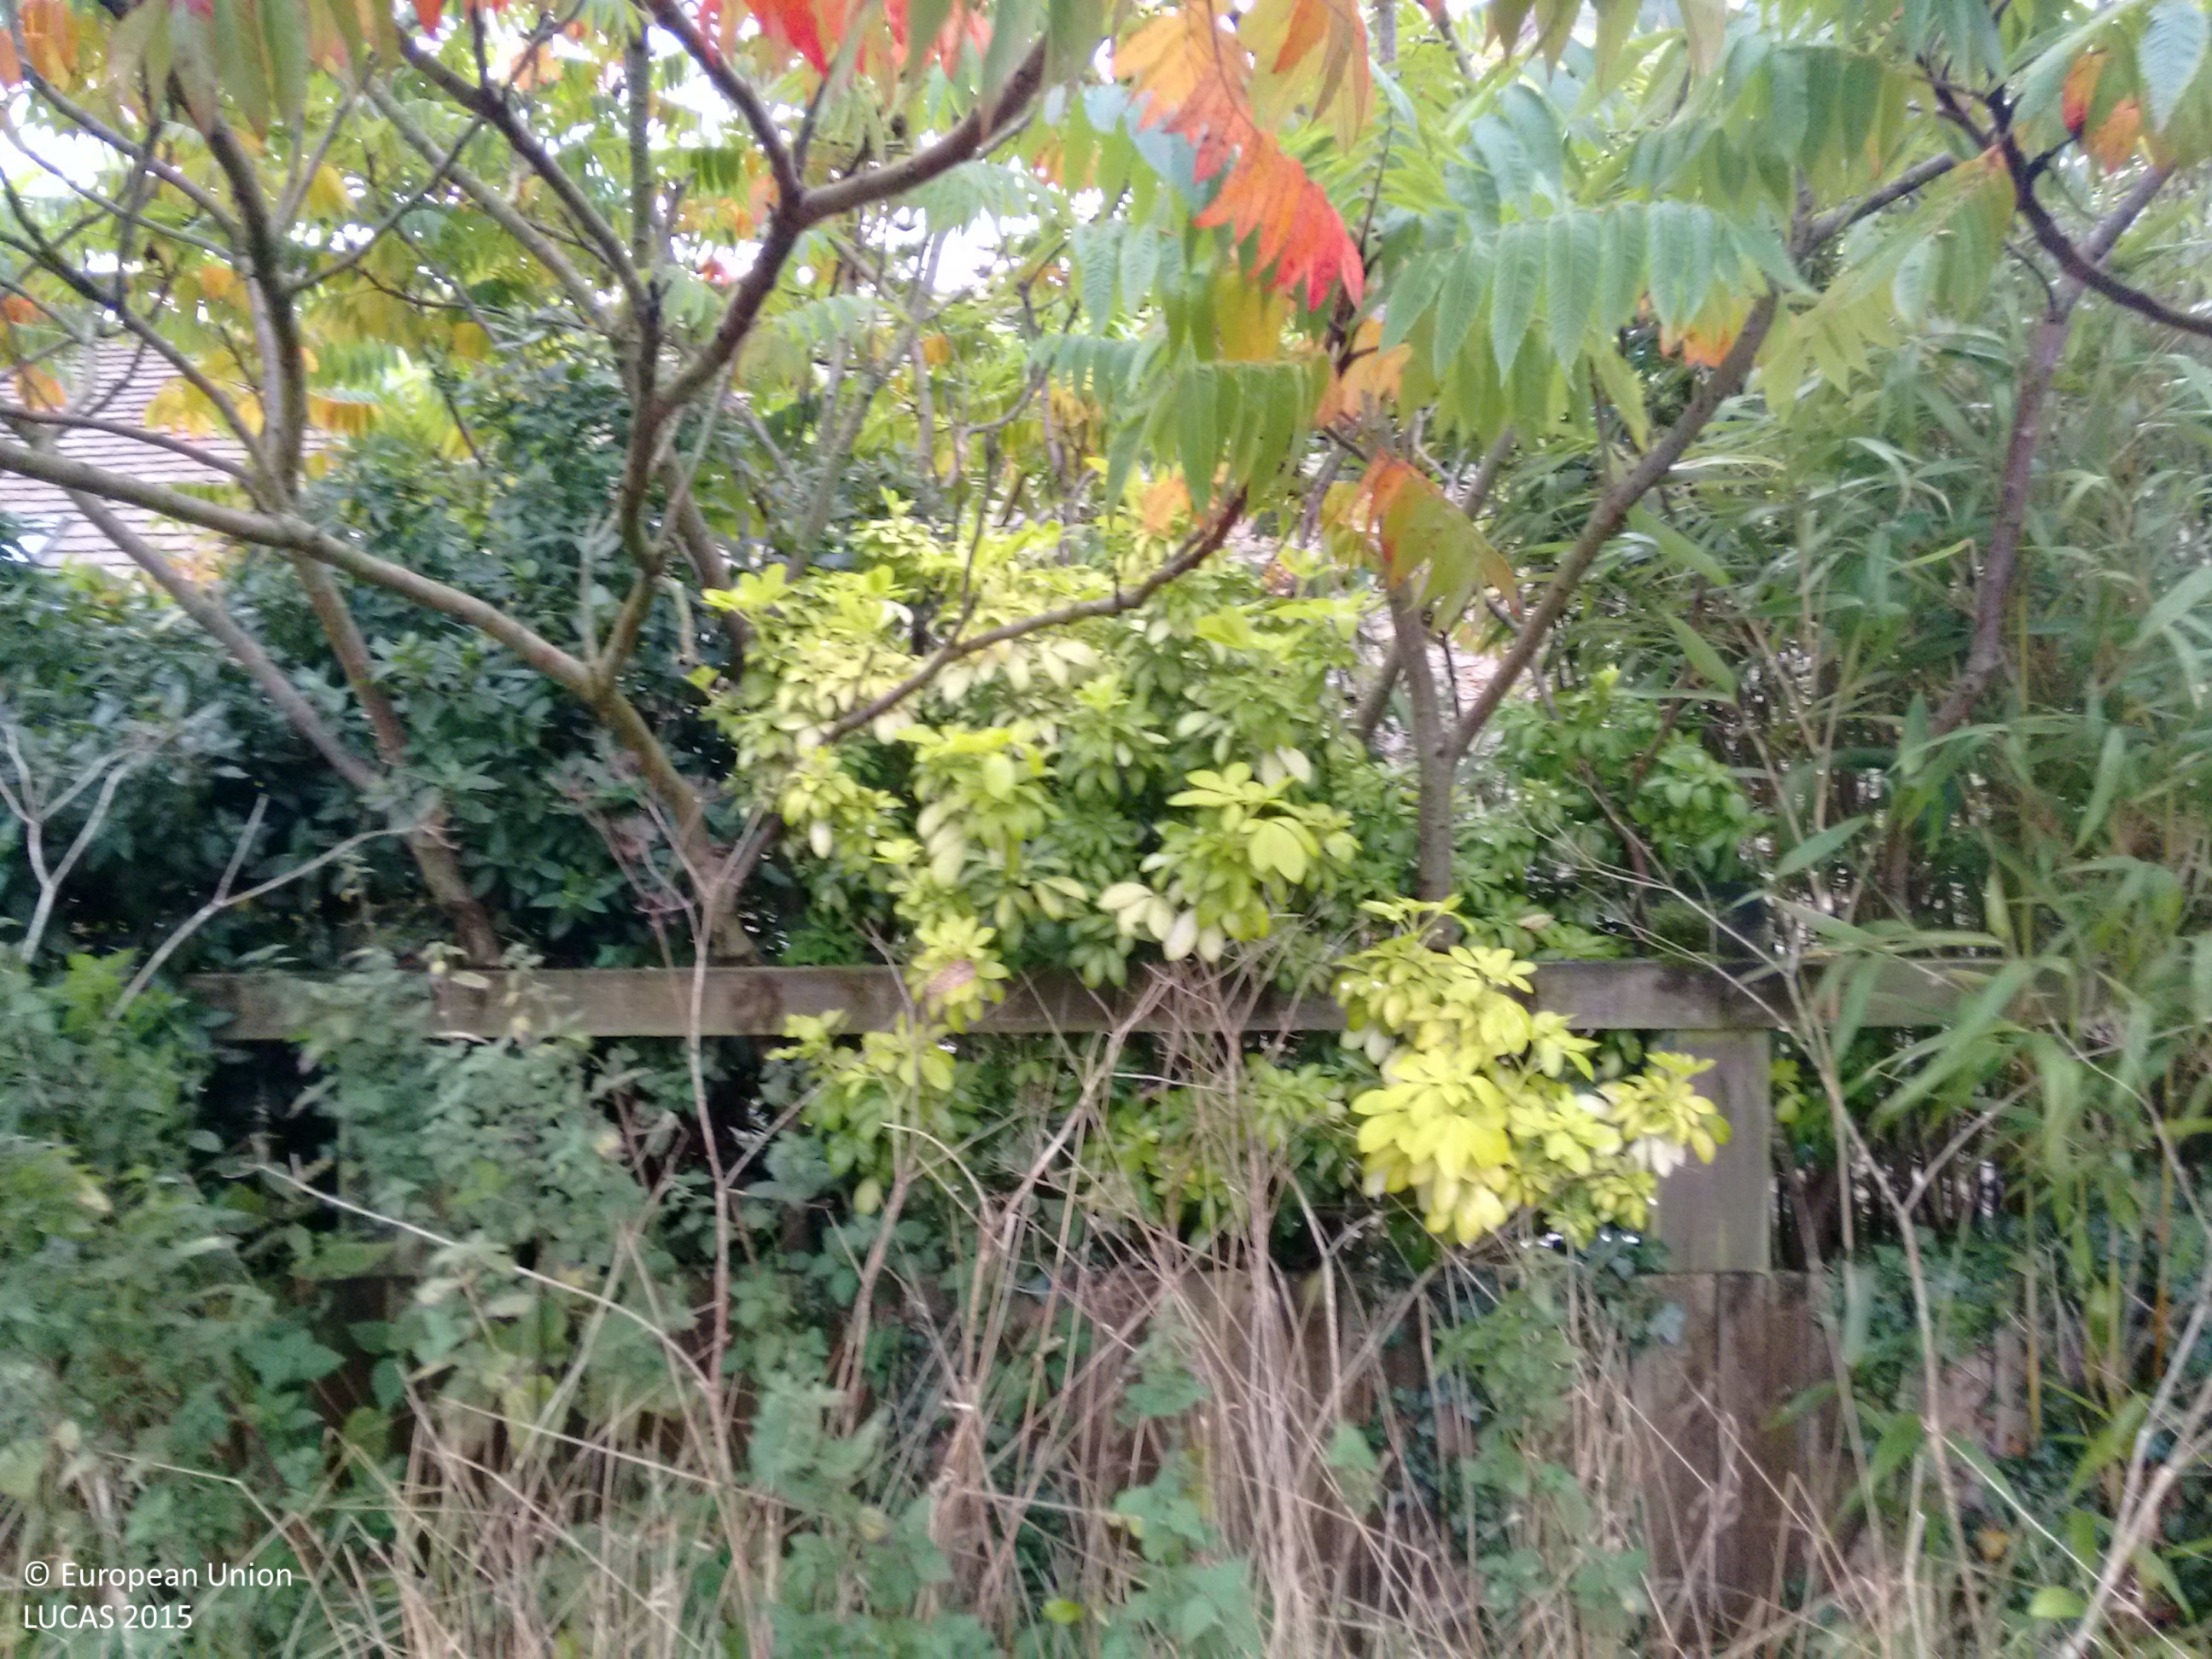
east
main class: Grassland
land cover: Grassland with sparse tree/shrub cover
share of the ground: > 75 %
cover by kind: herbaceous plants 90 %, broadleaved forest trees 5 %, shrubs 5 %
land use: Residential
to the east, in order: Grassland with sparse tree/shrub cover; Artificial constructions in urban areas; Broadleaved woodland; Artificial constructions in urban areas
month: October
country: GB
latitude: 51.7677
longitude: -1.9842
